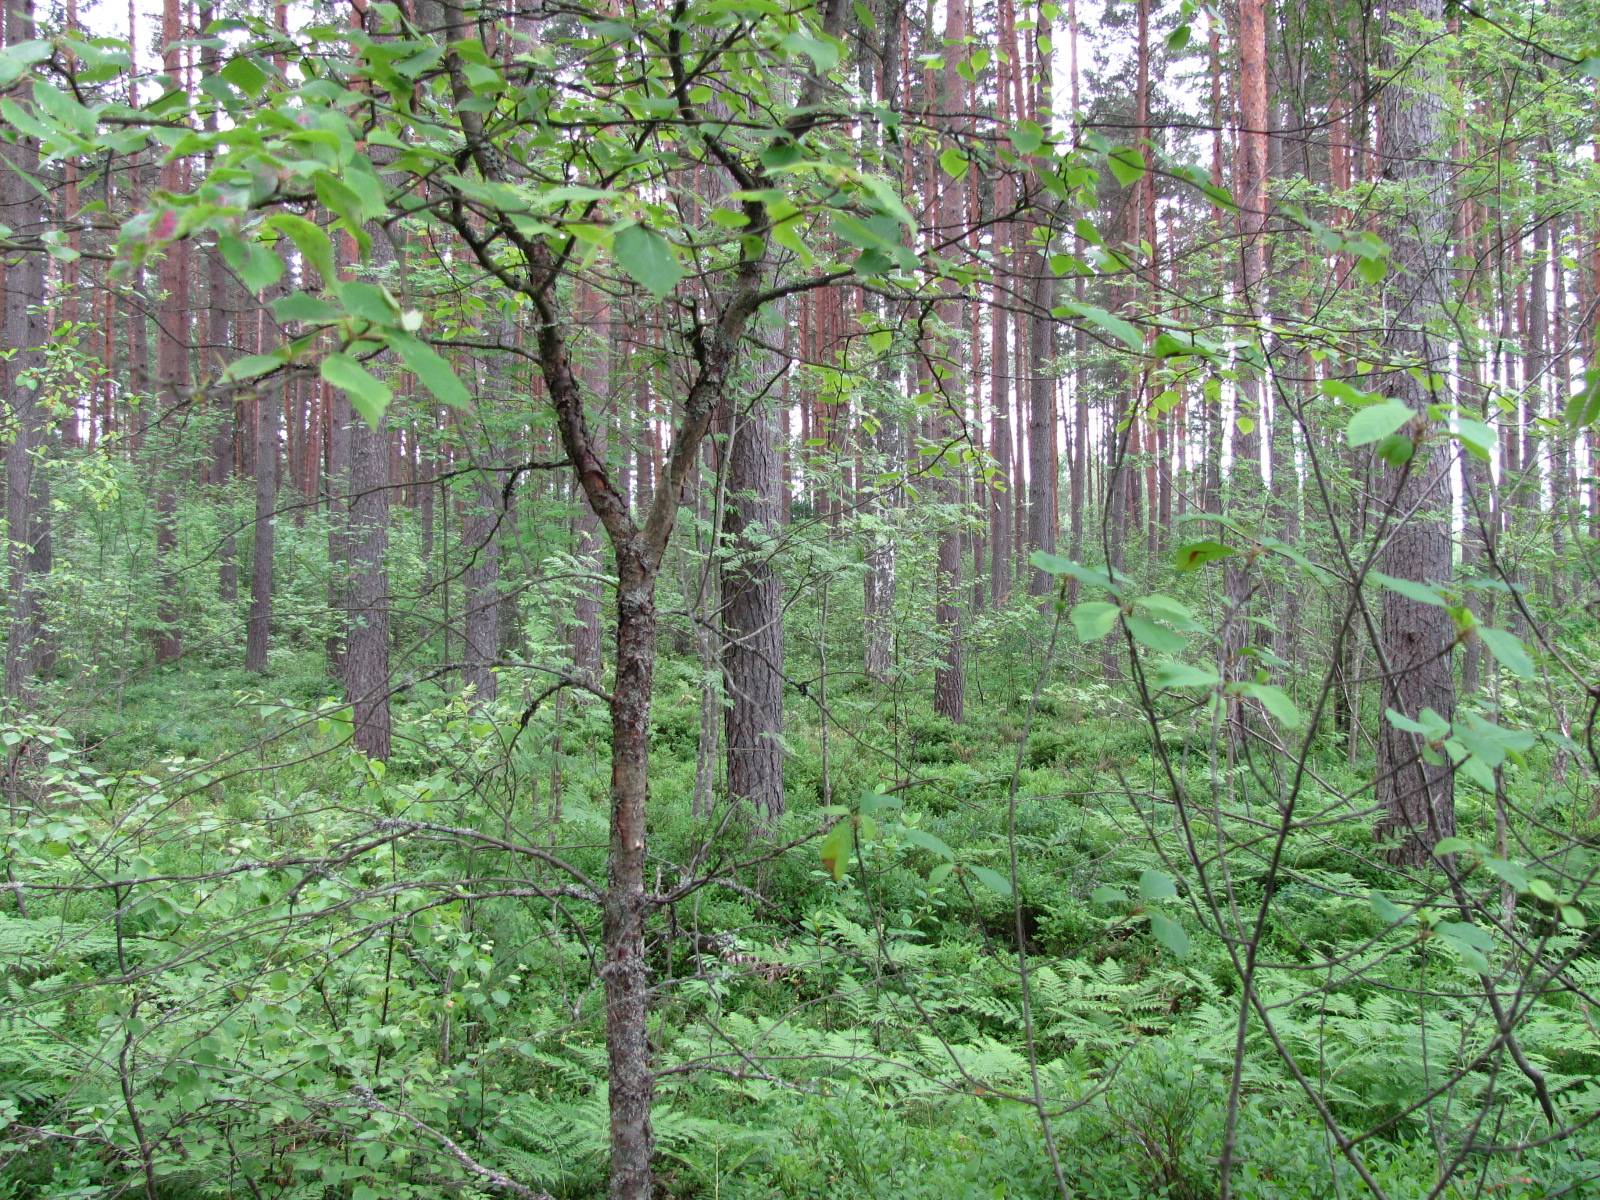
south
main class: Woodland
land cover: Pine dominated mixed woodland
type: hemiboreal forest and nemoral coniferous forest and mixed broadleaved-coniferous forest
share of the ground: > 75 %
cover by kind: coniferous forest trees 60 %, broadleaved forest trees 25 %, herbaceous plants 15 %
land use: Forestry
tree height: > 5 m
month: June
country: LV
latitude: 56.9078
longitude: 23.8920
